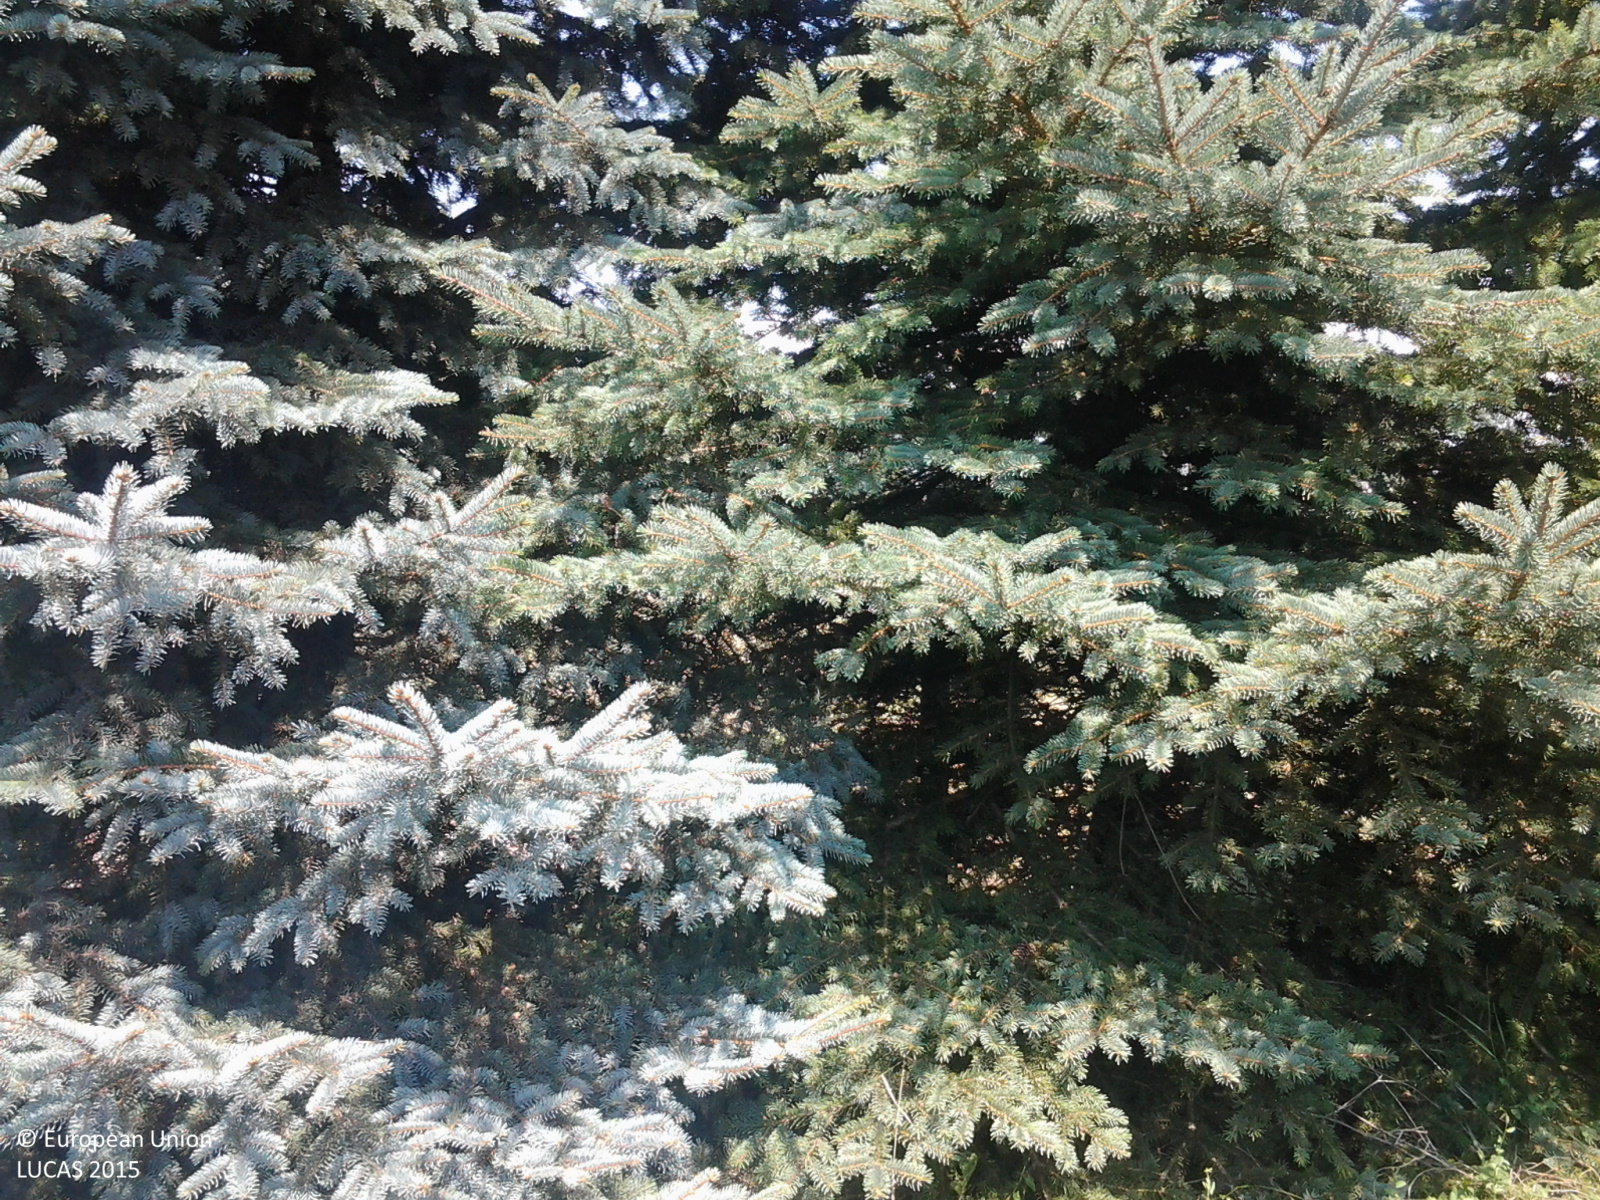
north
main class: Cropland
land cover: Maize
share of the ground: > 75 %
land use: Agriculture (excluding fallow land and kitchen gardens)
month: August
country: HU
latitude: 46.6020
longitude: 17.1184
